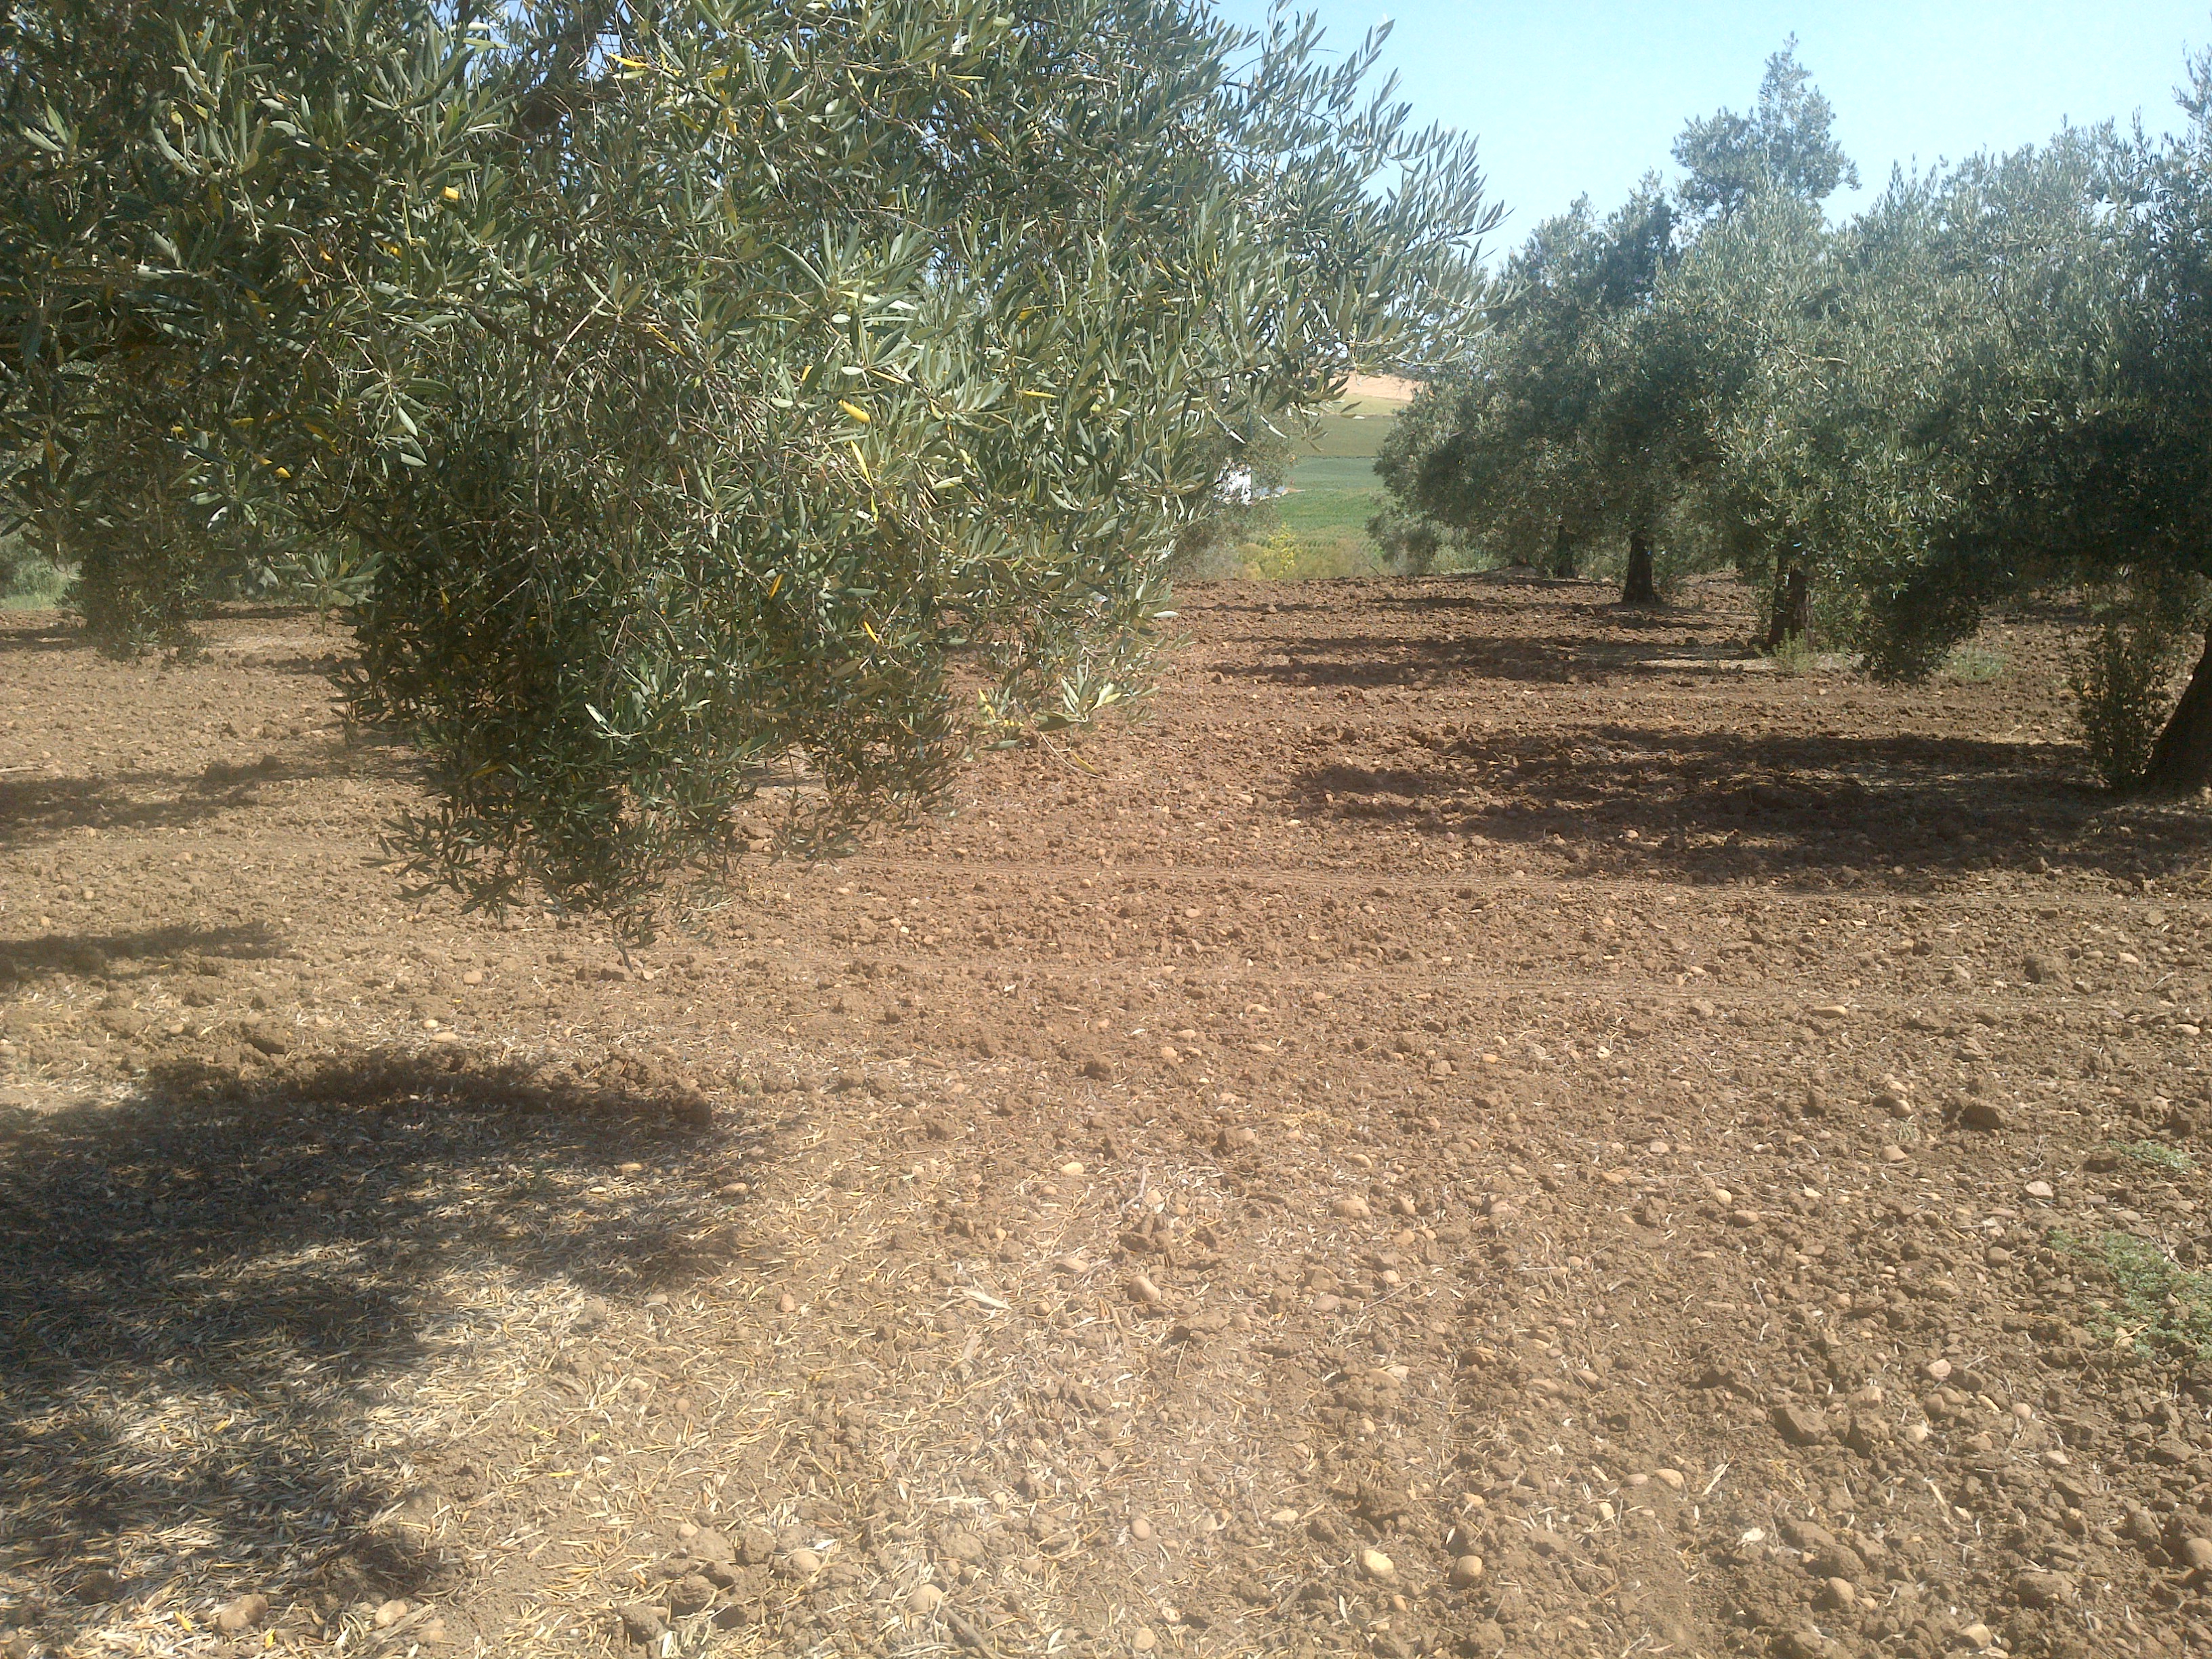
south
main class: Cropland
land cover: Olive groves
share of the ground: 50 - 75 %
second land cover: Other bare soil
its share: > 75 %
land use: Agriculture (excluding fallow land and kitchen gardens)
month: June
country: ES
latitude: 37.5854
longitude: -4.8567
